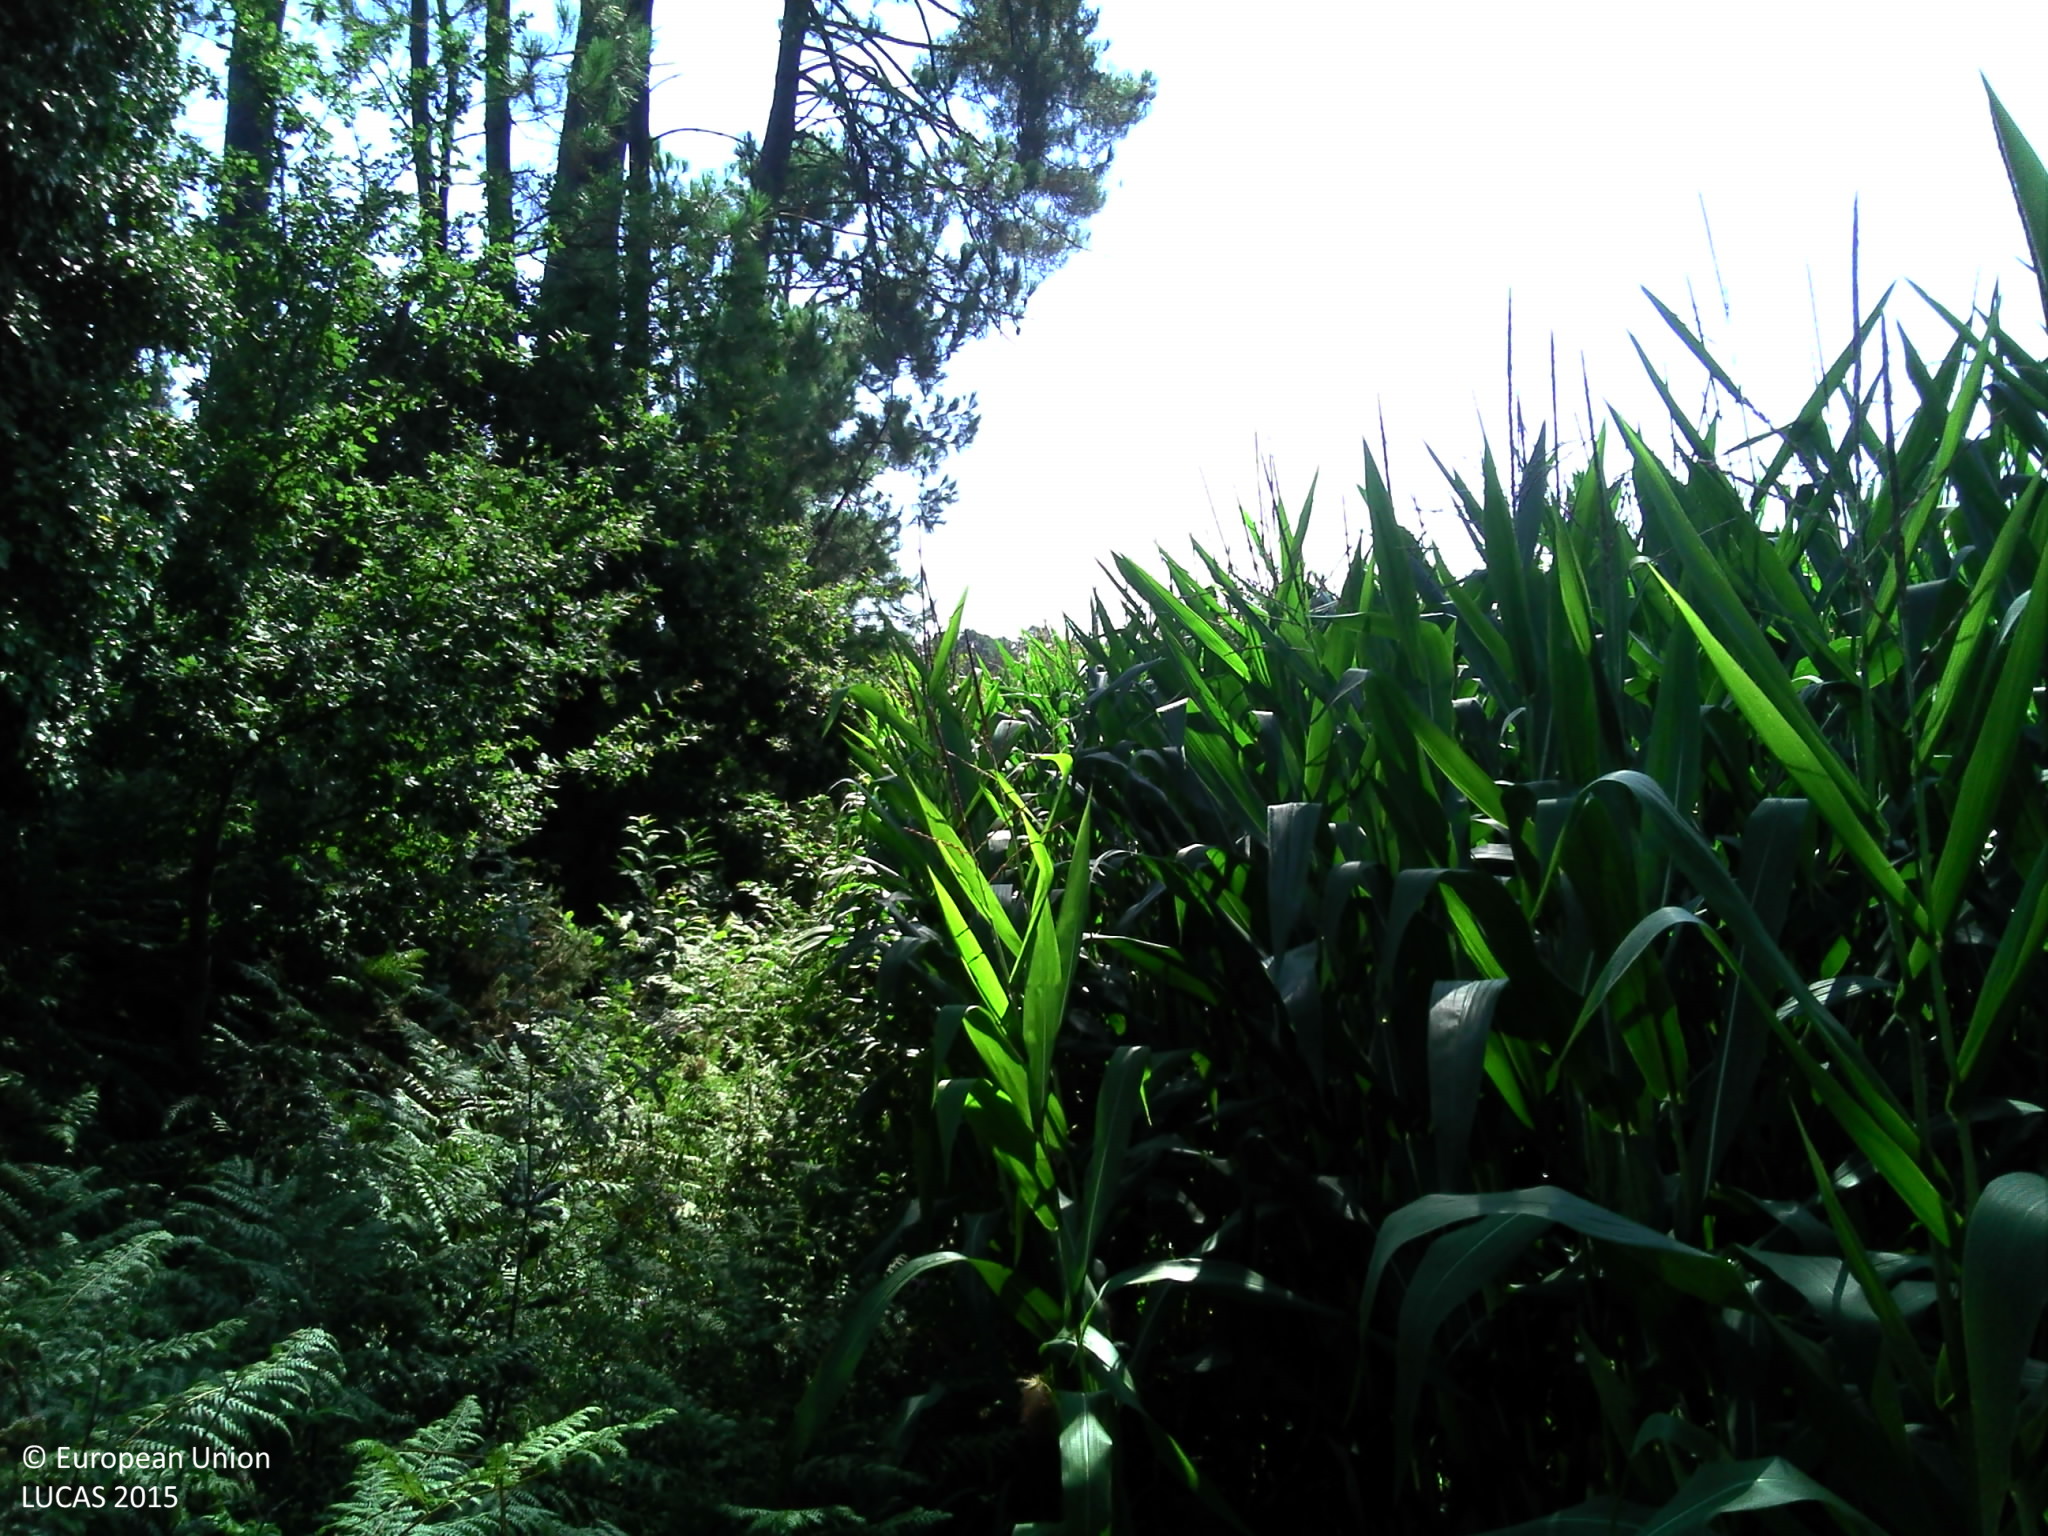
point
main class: Woodland
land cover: Pine dominated coniferous woodland
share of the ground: > 75 %
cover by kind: coniferous forest trees 80 %, herbaceous plants 15 %, shrubs 5 %
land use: Forestry
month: August
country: FR
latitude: 43.8070
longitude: -0.7662
